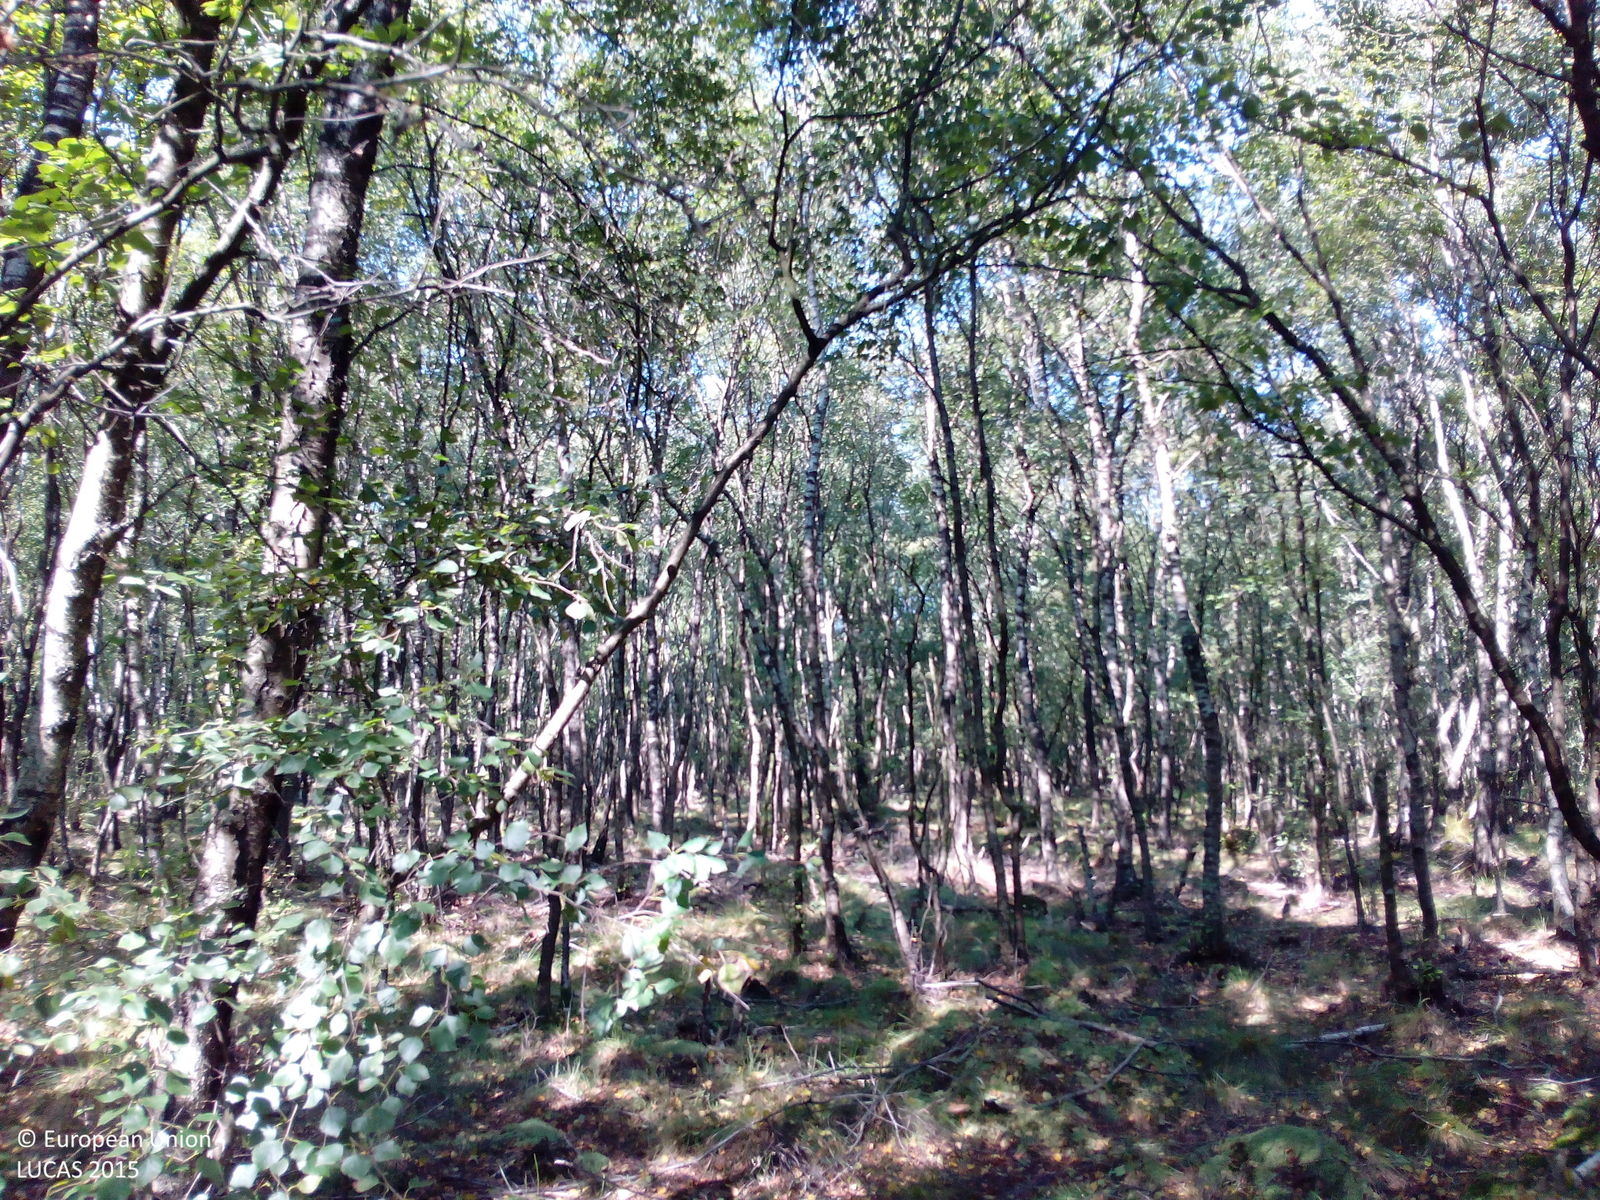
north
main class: Woodland
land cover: Broadleaved woodland
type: non-riverine alder, birch or aspen forest
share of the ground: > 75 %
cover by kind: broadleaved forest trees 80 %, herbaceous plants 10 %, shrubs 5 %, lichens and mosses 5 %
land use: Forestry
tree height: > 5 m
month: August
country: DE
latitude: 52.7921
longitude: 7.9986
